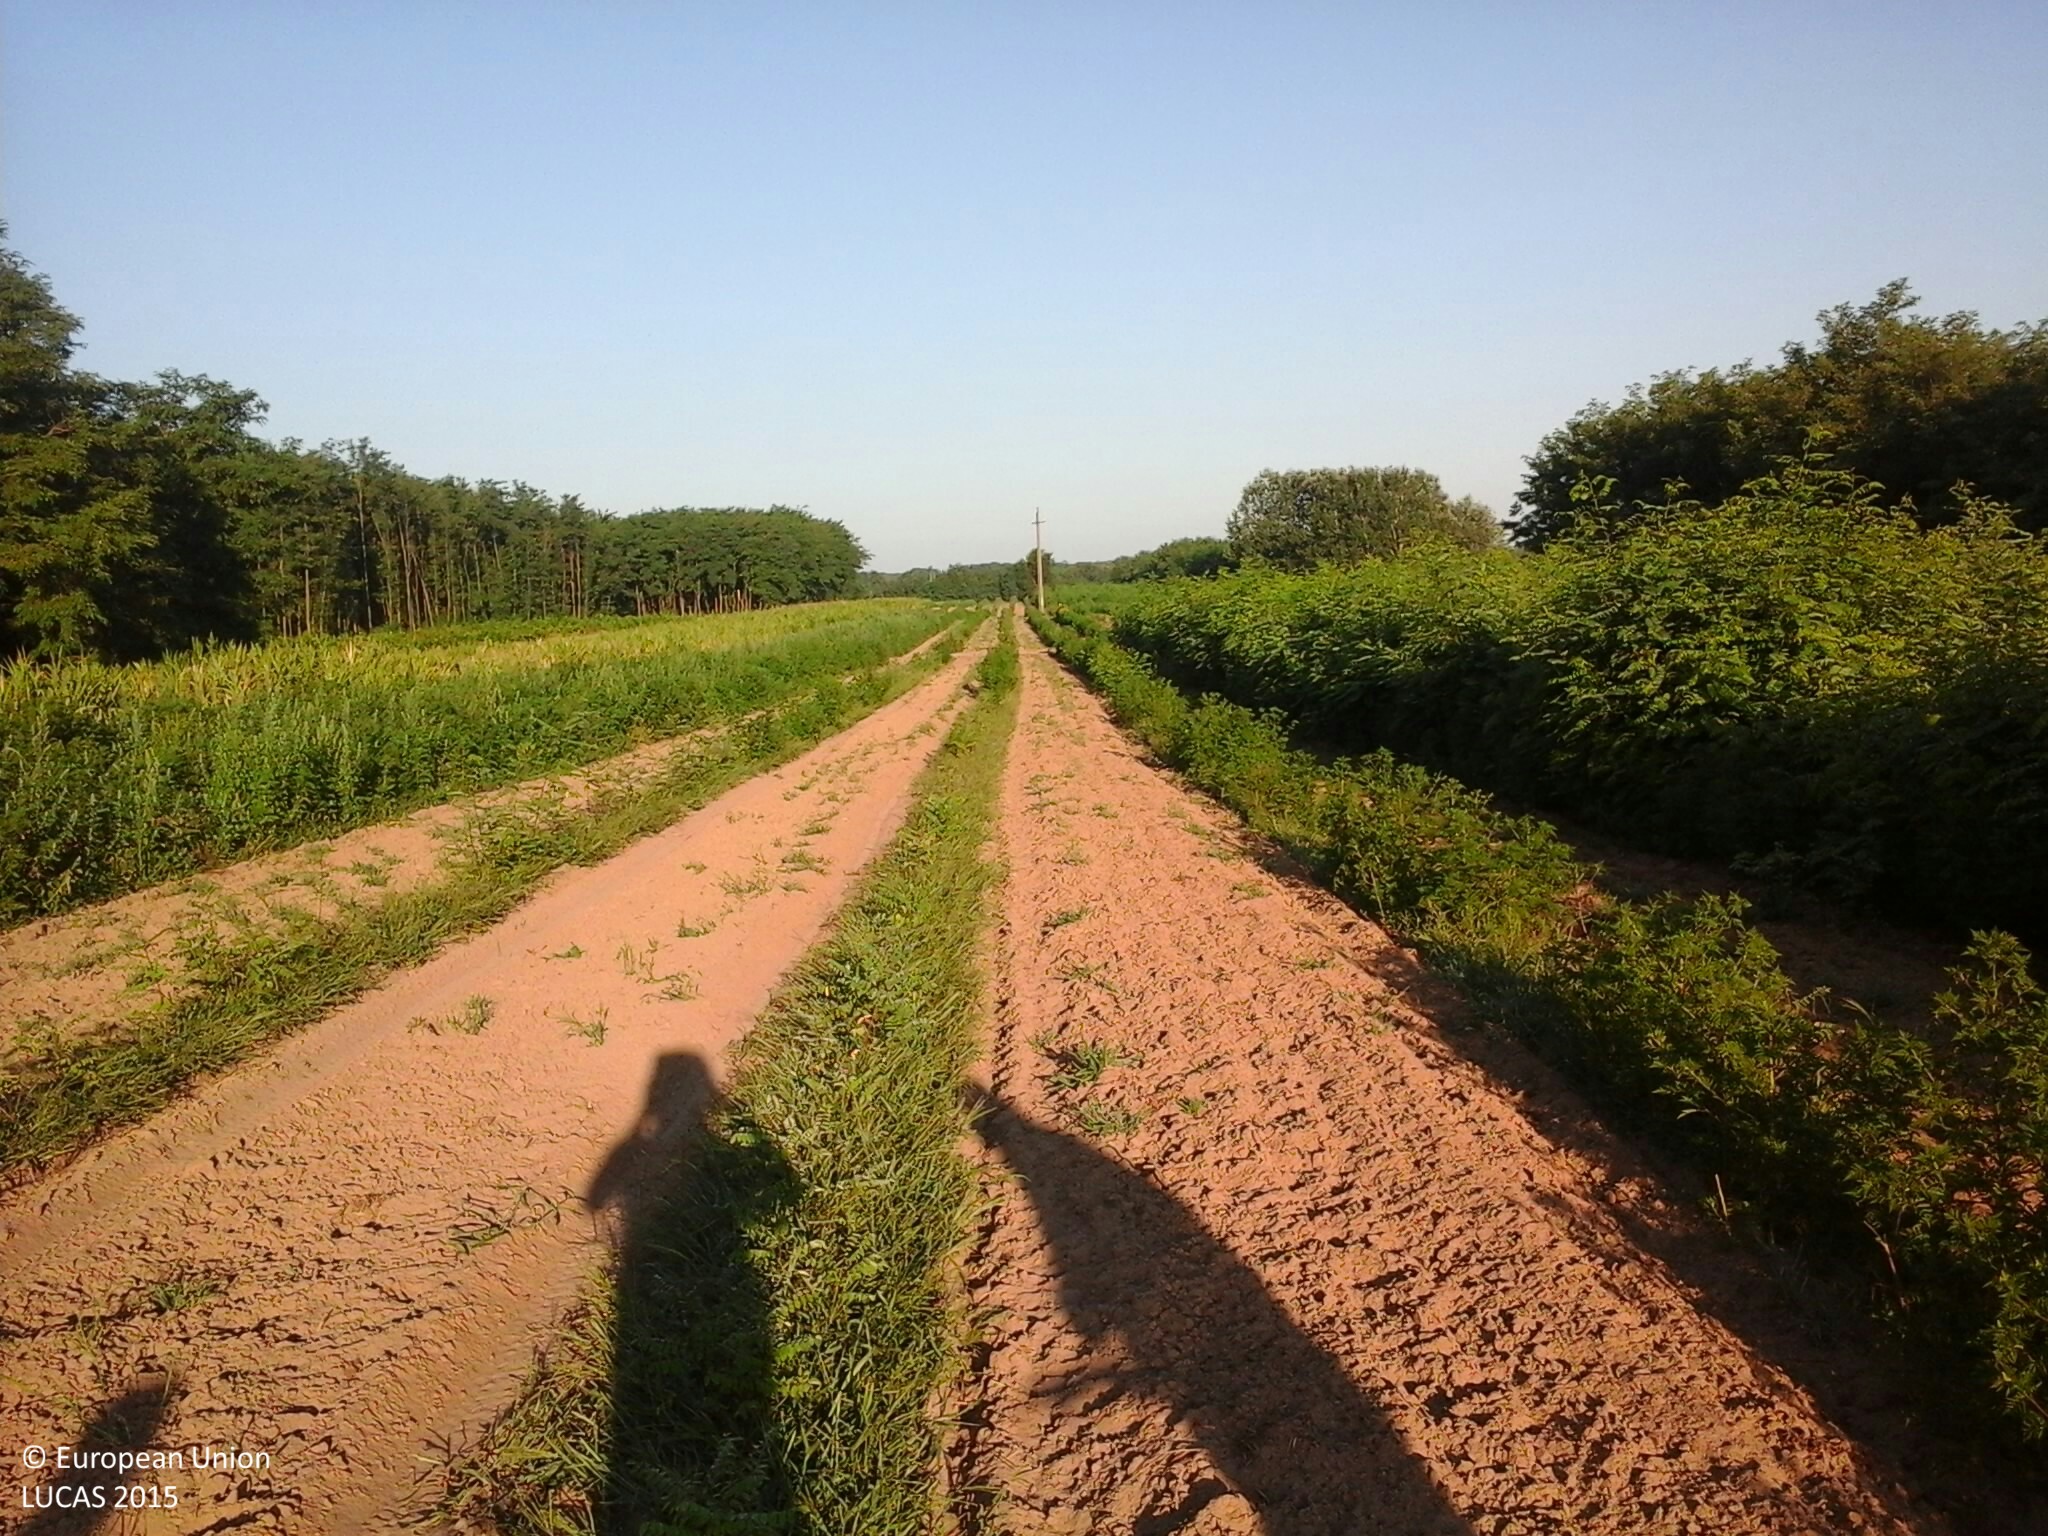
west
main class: Woodland
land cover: Broadleaved woodland
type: exotic forest
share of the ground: 25 - 50 %
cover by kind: unconsolidated bare surface 50 %, broadleaved forest trees 40 %, herbaceous plants 10 %
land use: Forestry
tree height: < 5 m
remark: Nursery
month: July
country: HU
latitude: 47.6985
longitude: 22.1116
